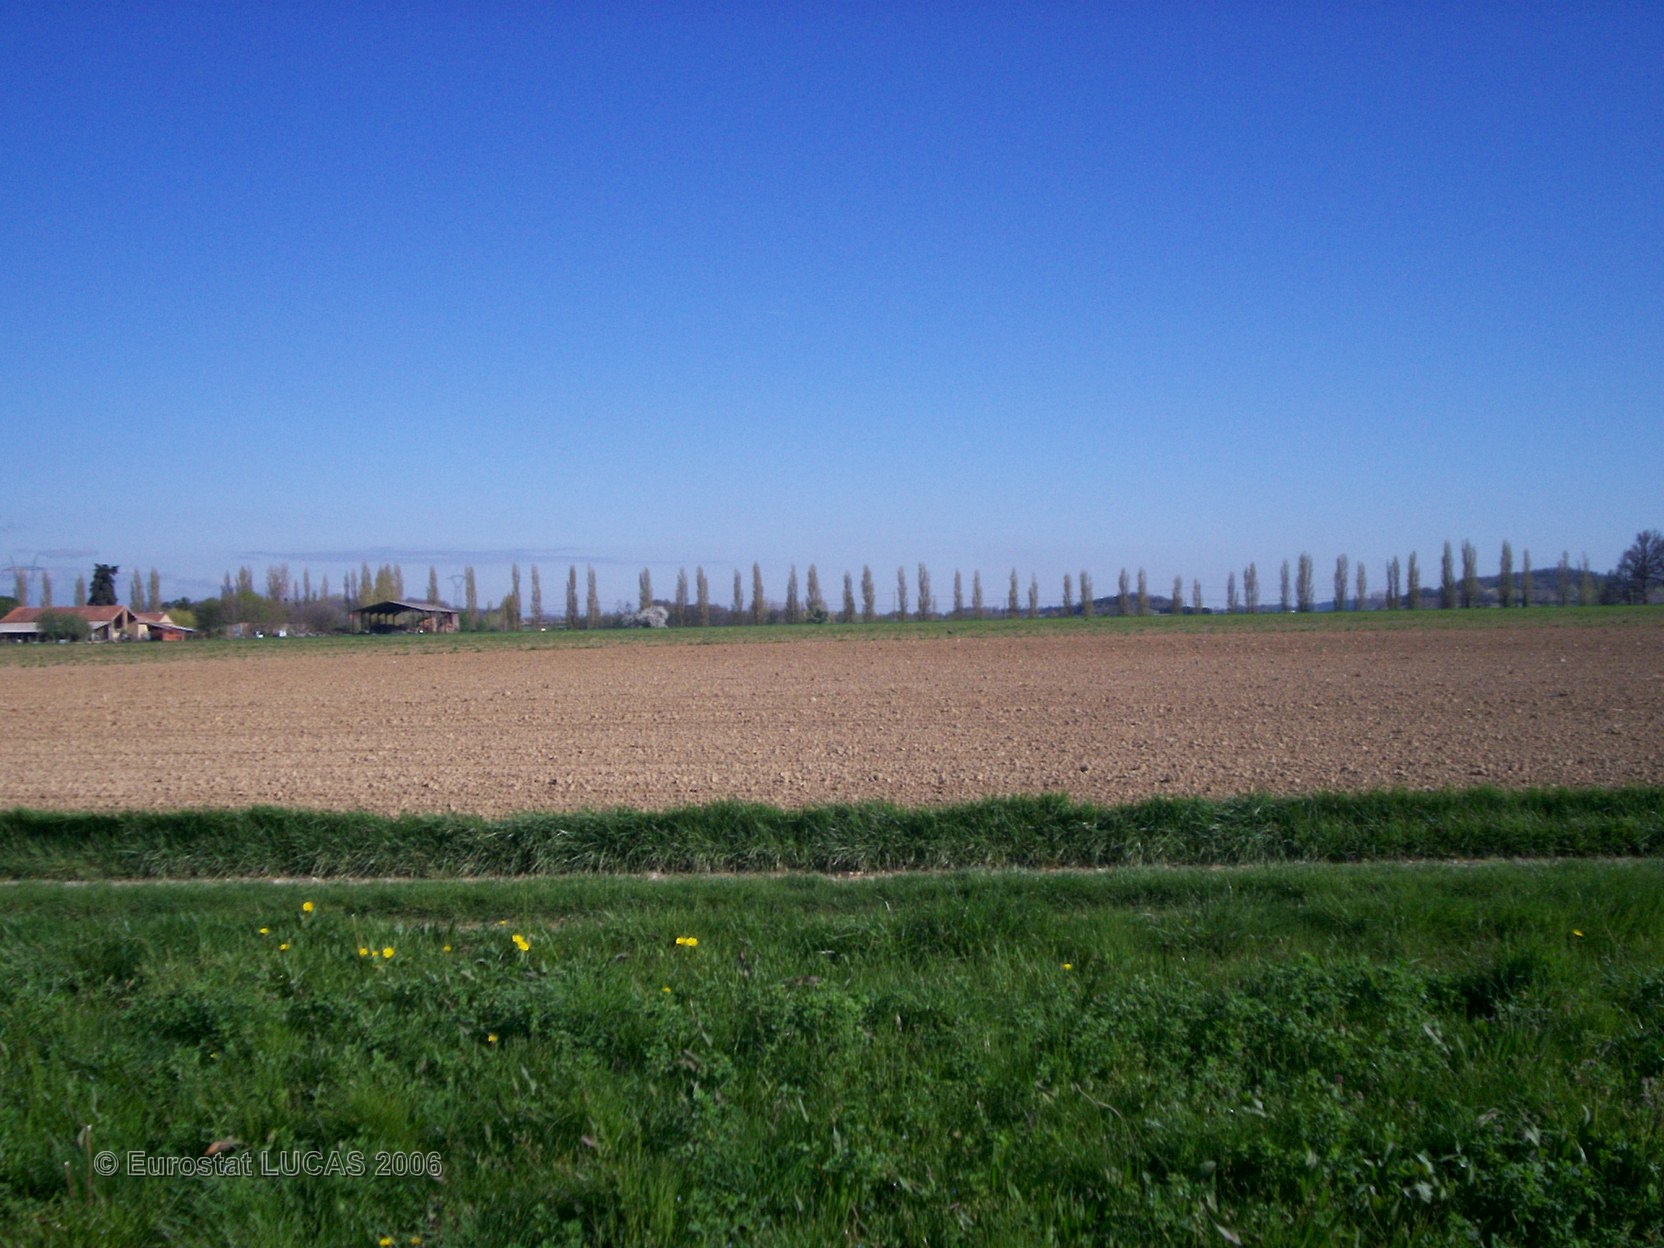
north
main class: Grassland
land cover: Grassland without tree/shrub cover
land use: Agriculture (excluding fallow land and kitchen gardens)
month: April
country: FR
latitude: 44.7858
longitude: 4.9127
